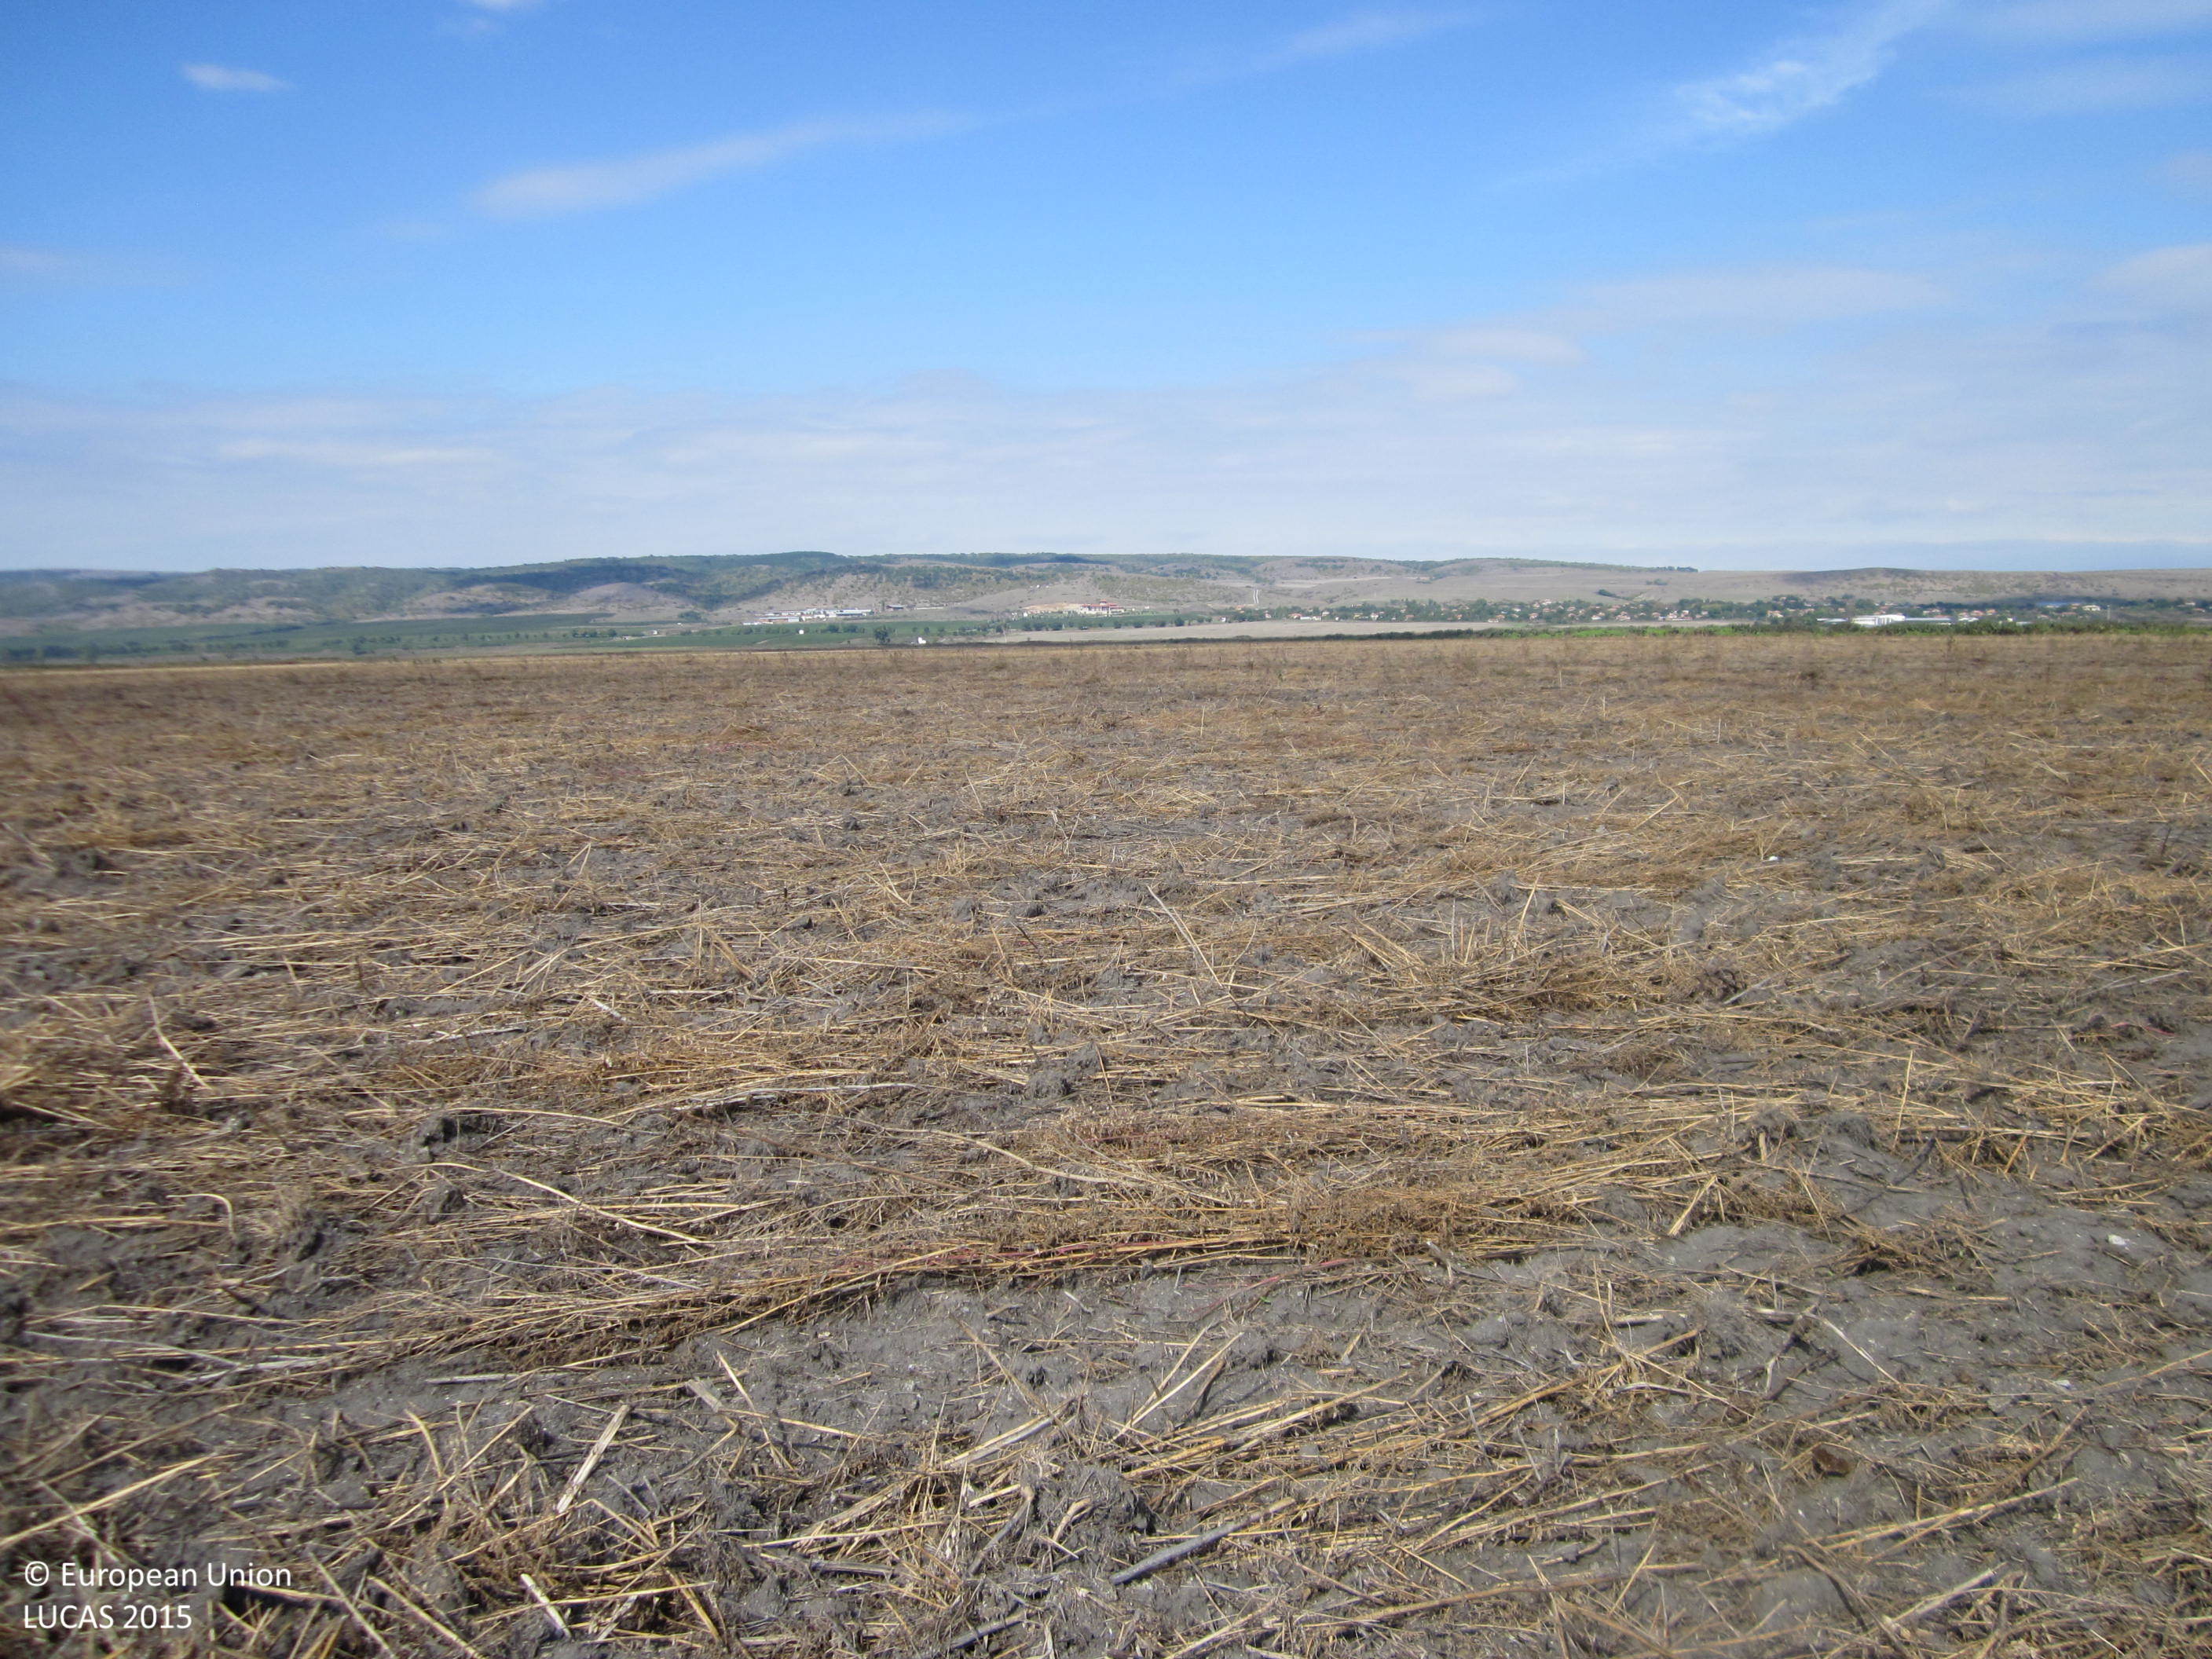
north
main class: Cropland
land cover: Sunflower
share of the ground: 10 - 25 %
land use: Agriculture (excluding fallow land and kitchen gardens)
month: October
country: BG
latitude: 42.6207
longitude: 26.7918
